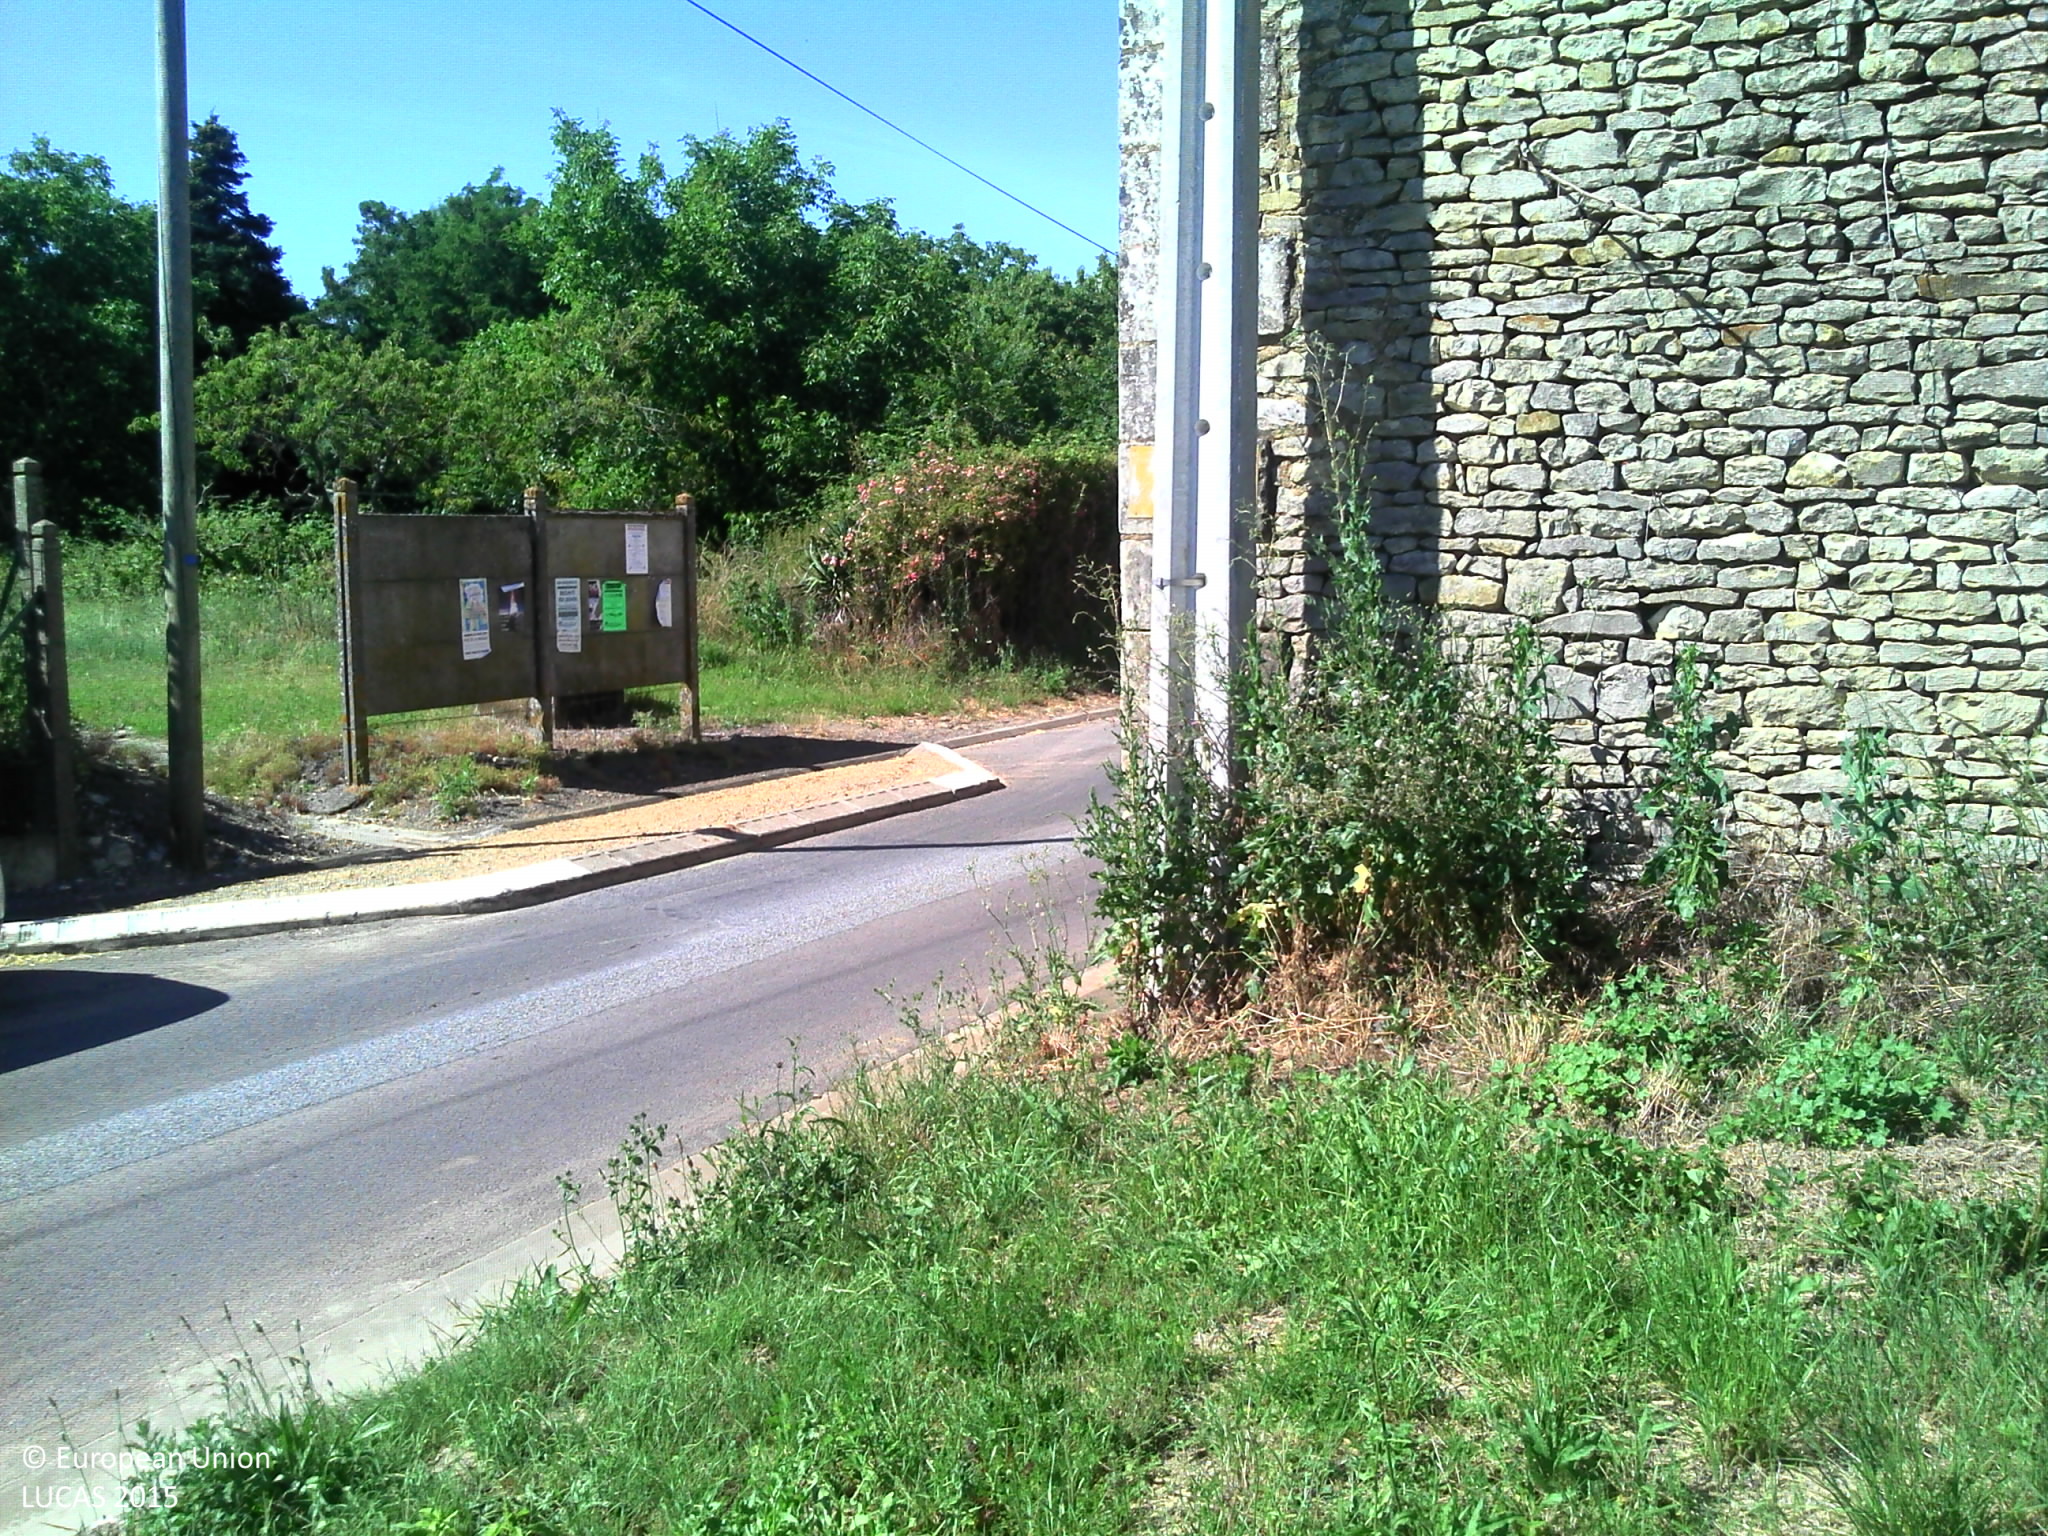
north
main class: Grassland
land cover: Spontaneously vegetated surfaces
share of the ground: > 75 %
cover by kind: herbaceous plants 100 %
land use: Semi-natural and natural areas not in use
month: June
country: FR
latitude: 46.8726
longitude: 0.1246
